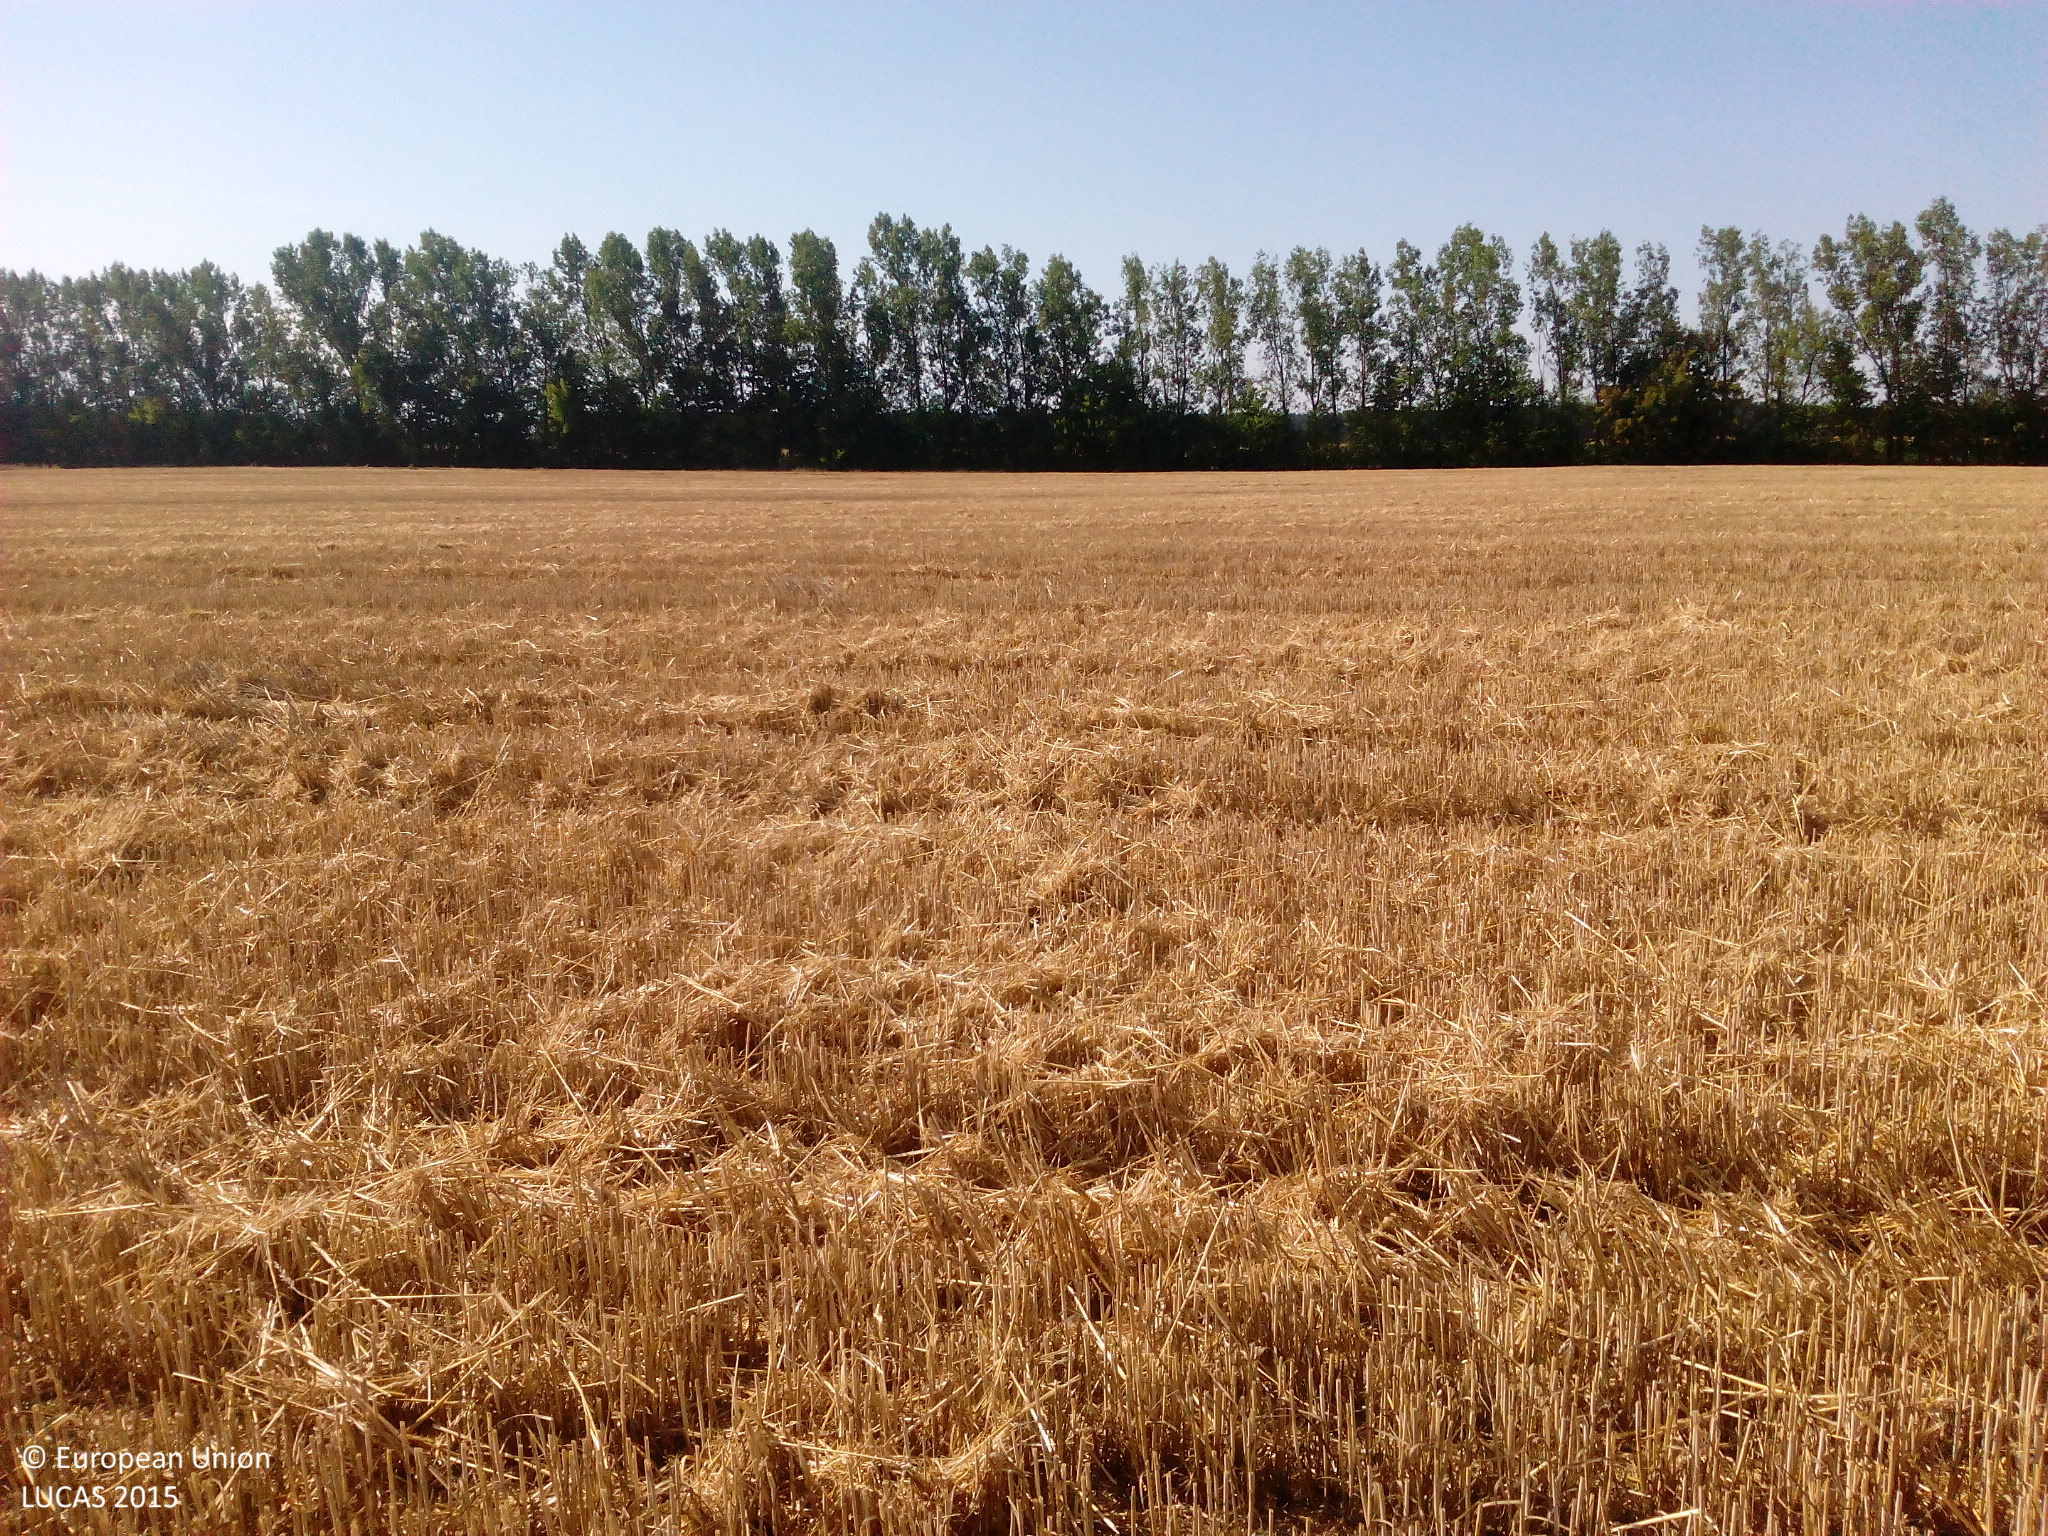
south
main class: Cropland
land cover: Common wheat
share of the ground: 50 - 75 %
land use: Agriculture (excluding fallow land and kitchen gardens)
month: August
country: DE
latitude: 51.9241
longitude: 13.0682
